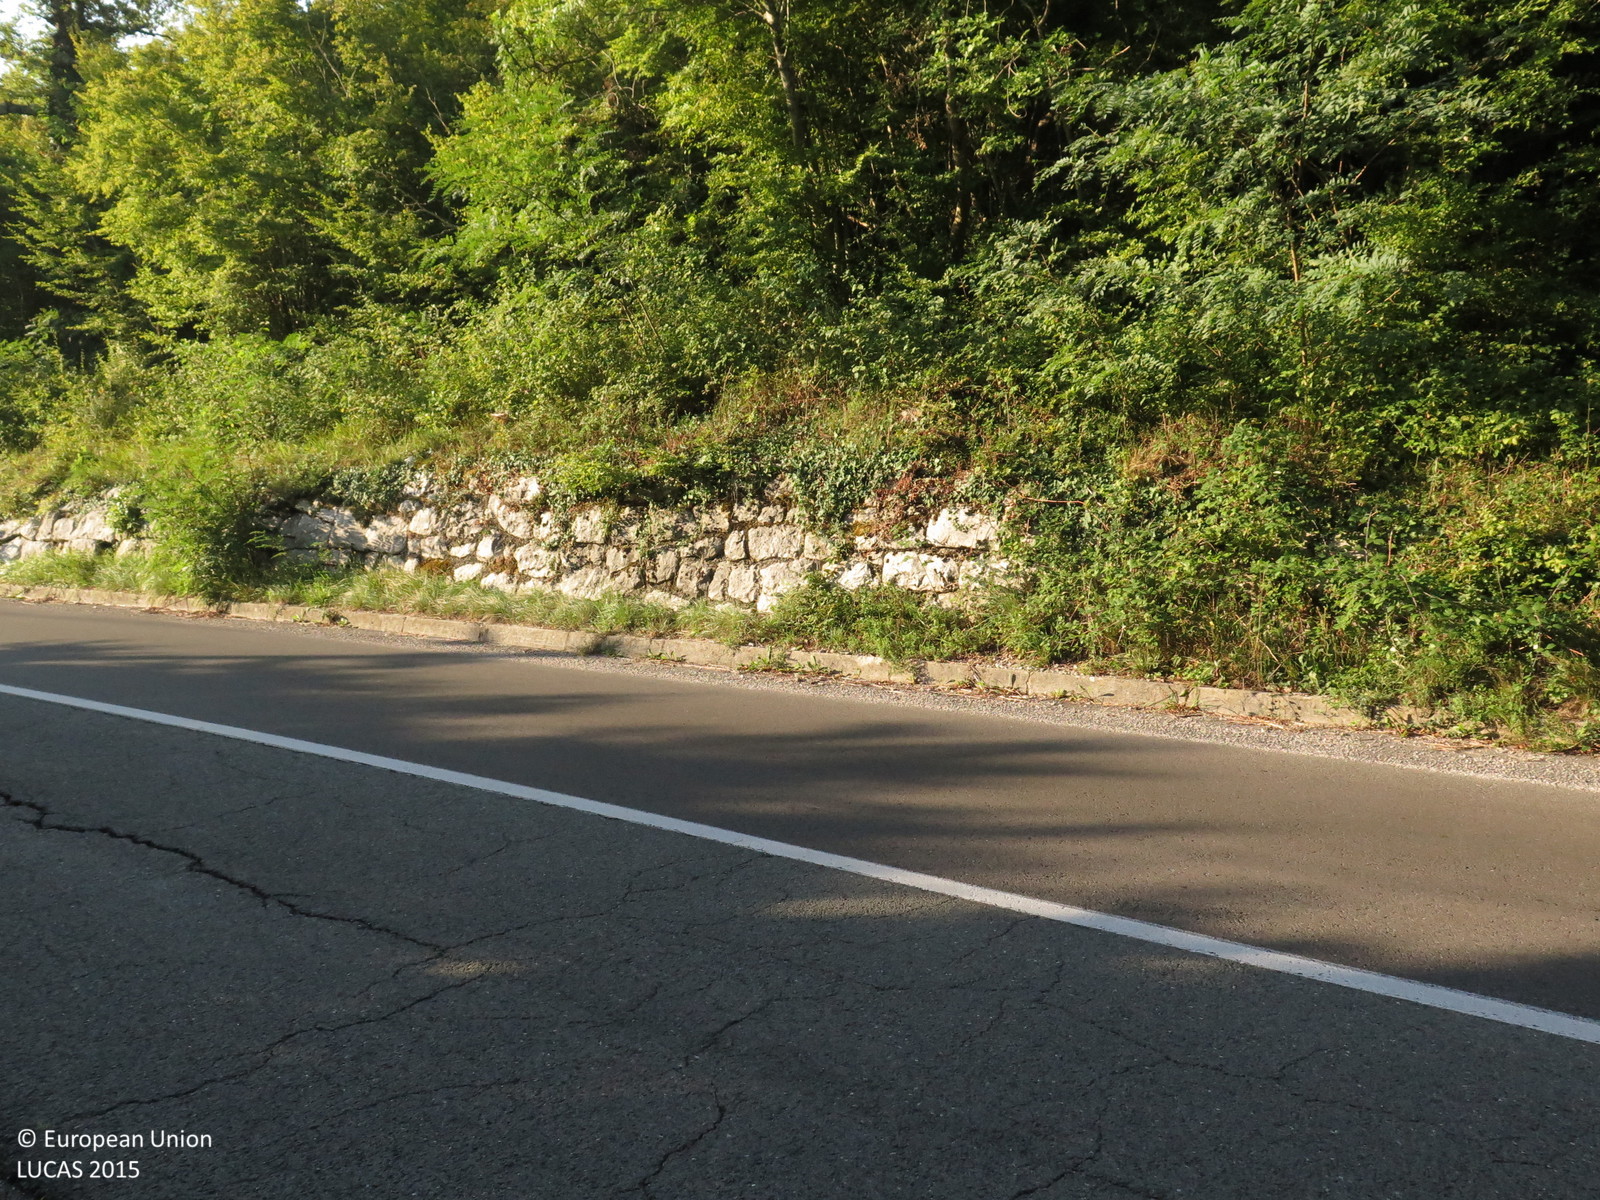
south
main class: Shrubland
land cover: Shrubland with sparse tree cover
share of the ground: > 75 %
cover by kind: shrubs 90 %, broadleaved forest trees 5 %, herbaceous plants 5 %
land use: Semi-natural and natural areas not in use
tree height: < 5 m
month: August
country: HR
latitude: 45.2015
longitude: 14.6923
